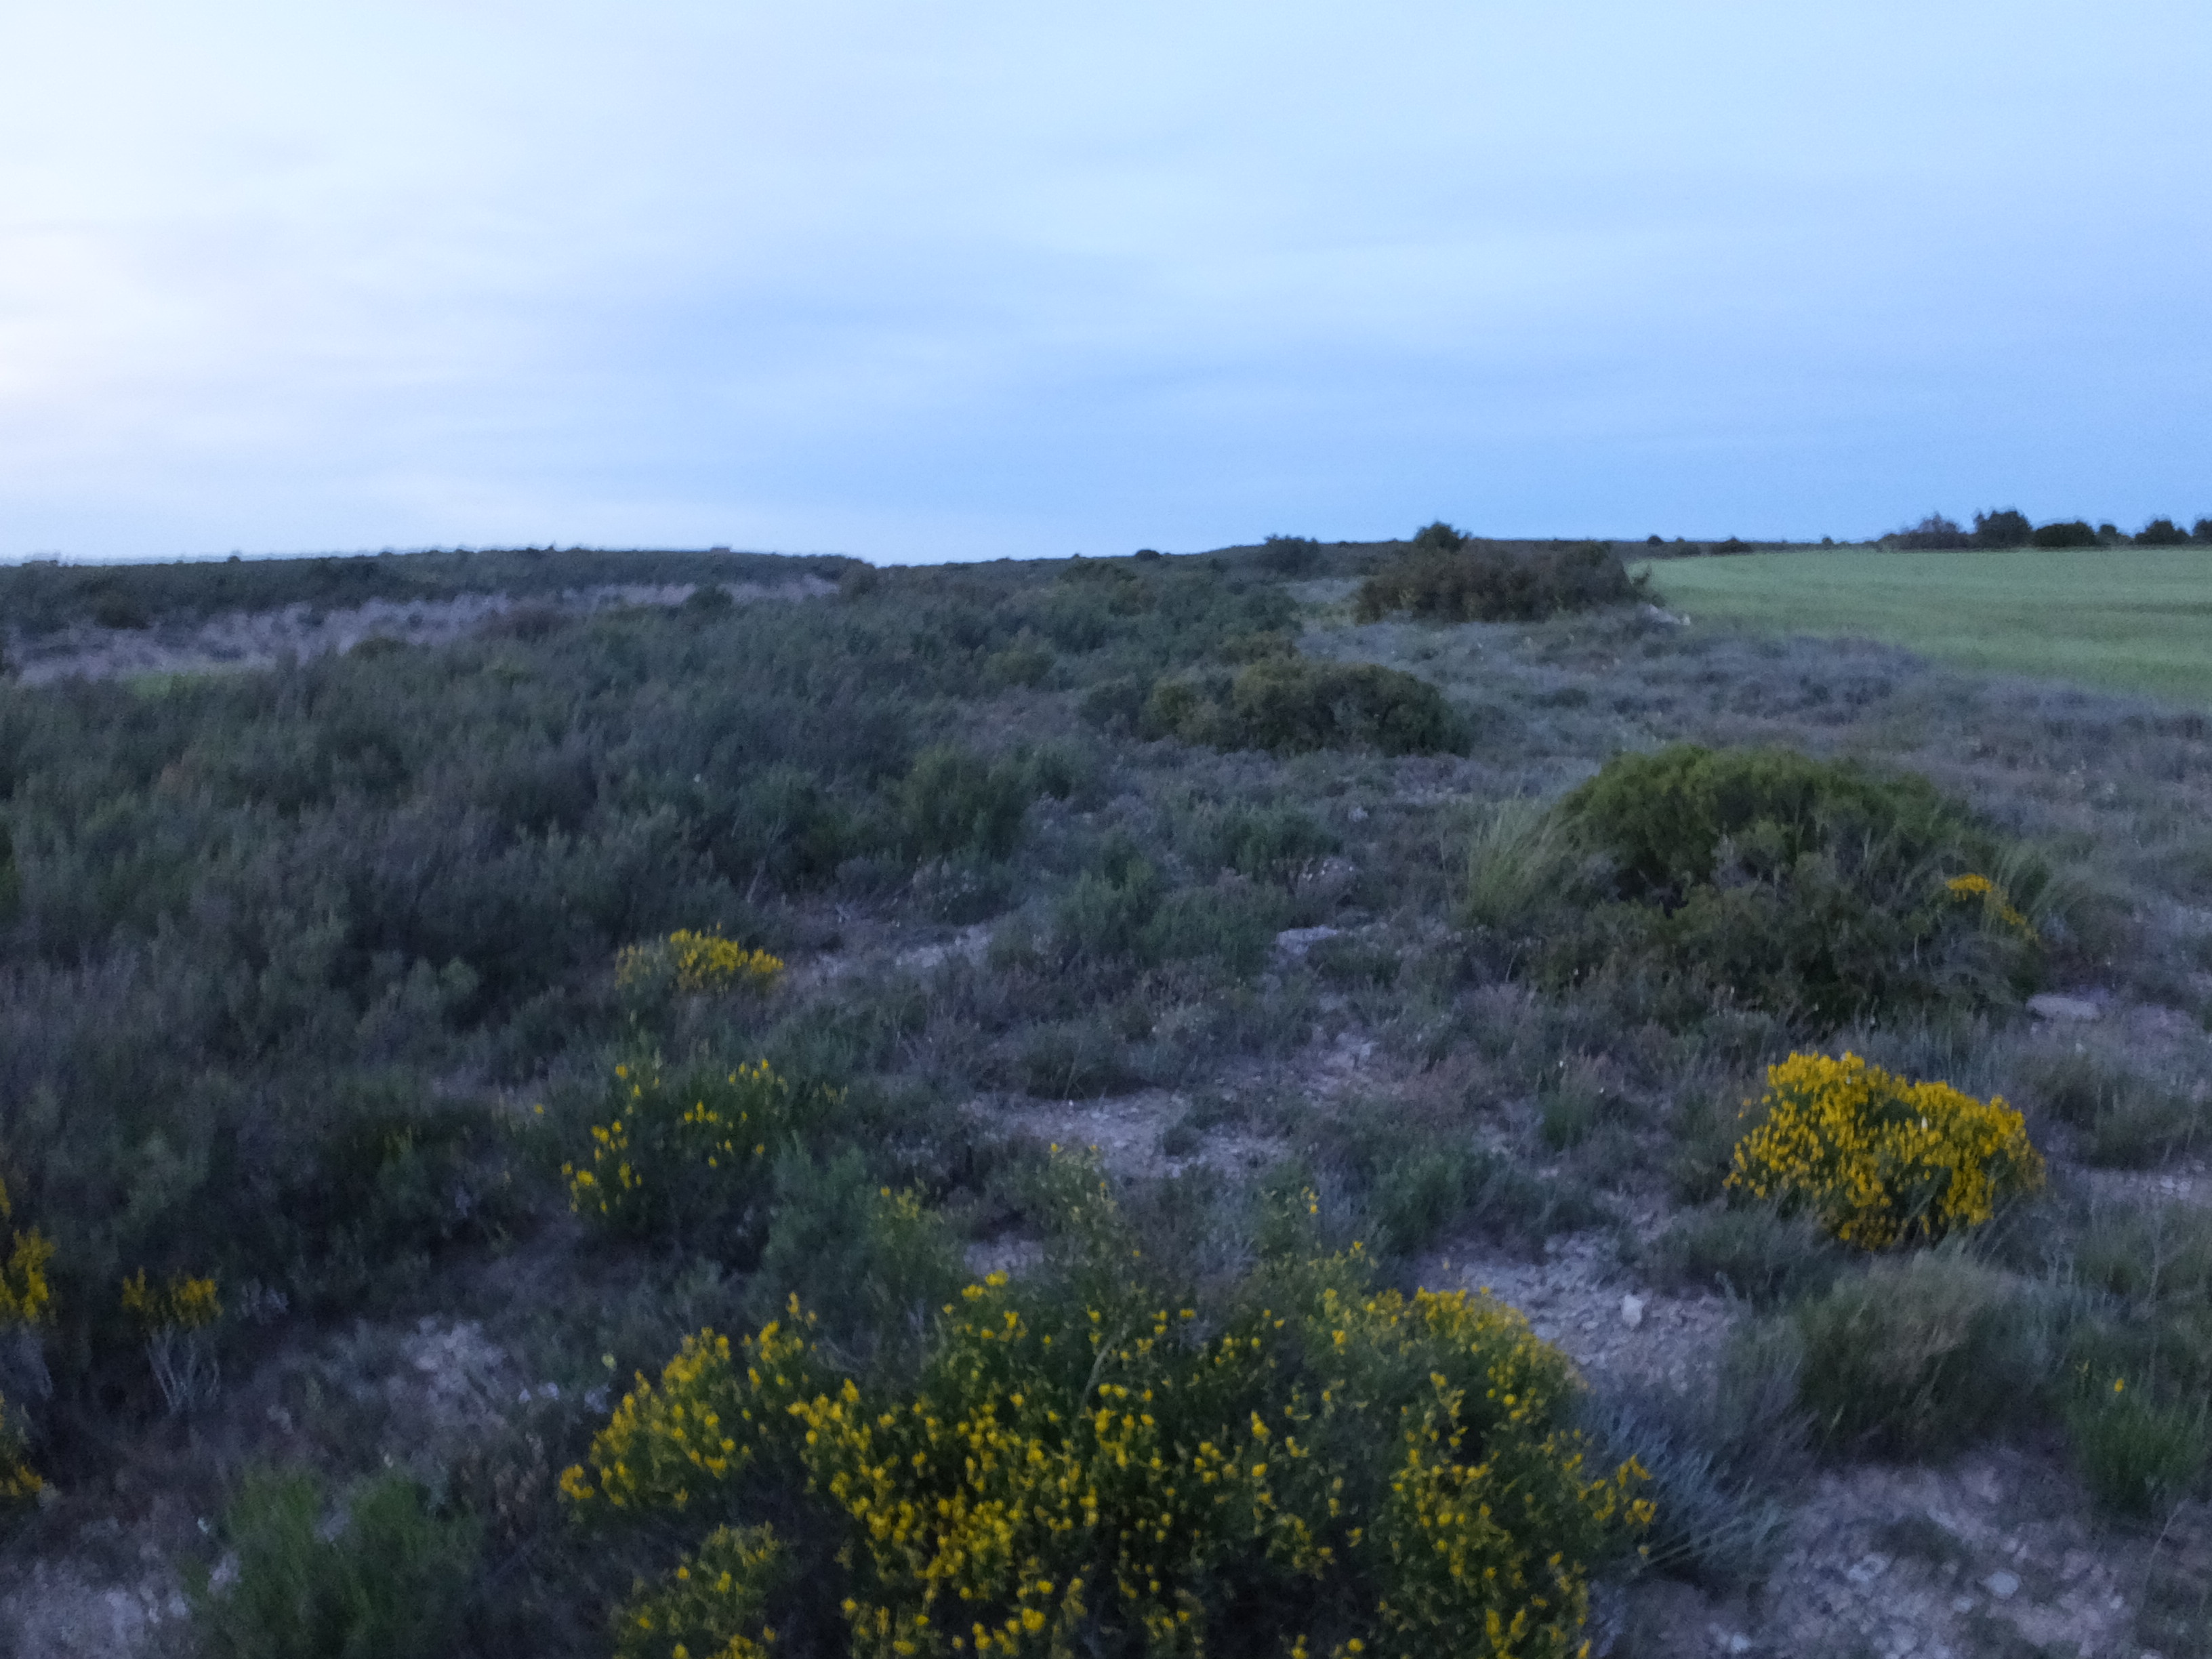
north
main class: Shrubland
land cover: Shrubland with sparse tree cover
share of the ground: > 75 %
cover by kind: shrubs 75 %, herbaceous plants 20 %, coniferous forest trees 5 %
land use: Semi-natural and natural areas not in use
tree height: < 5 m
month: April
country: ES
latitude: 41.6373
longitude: -0.1125
